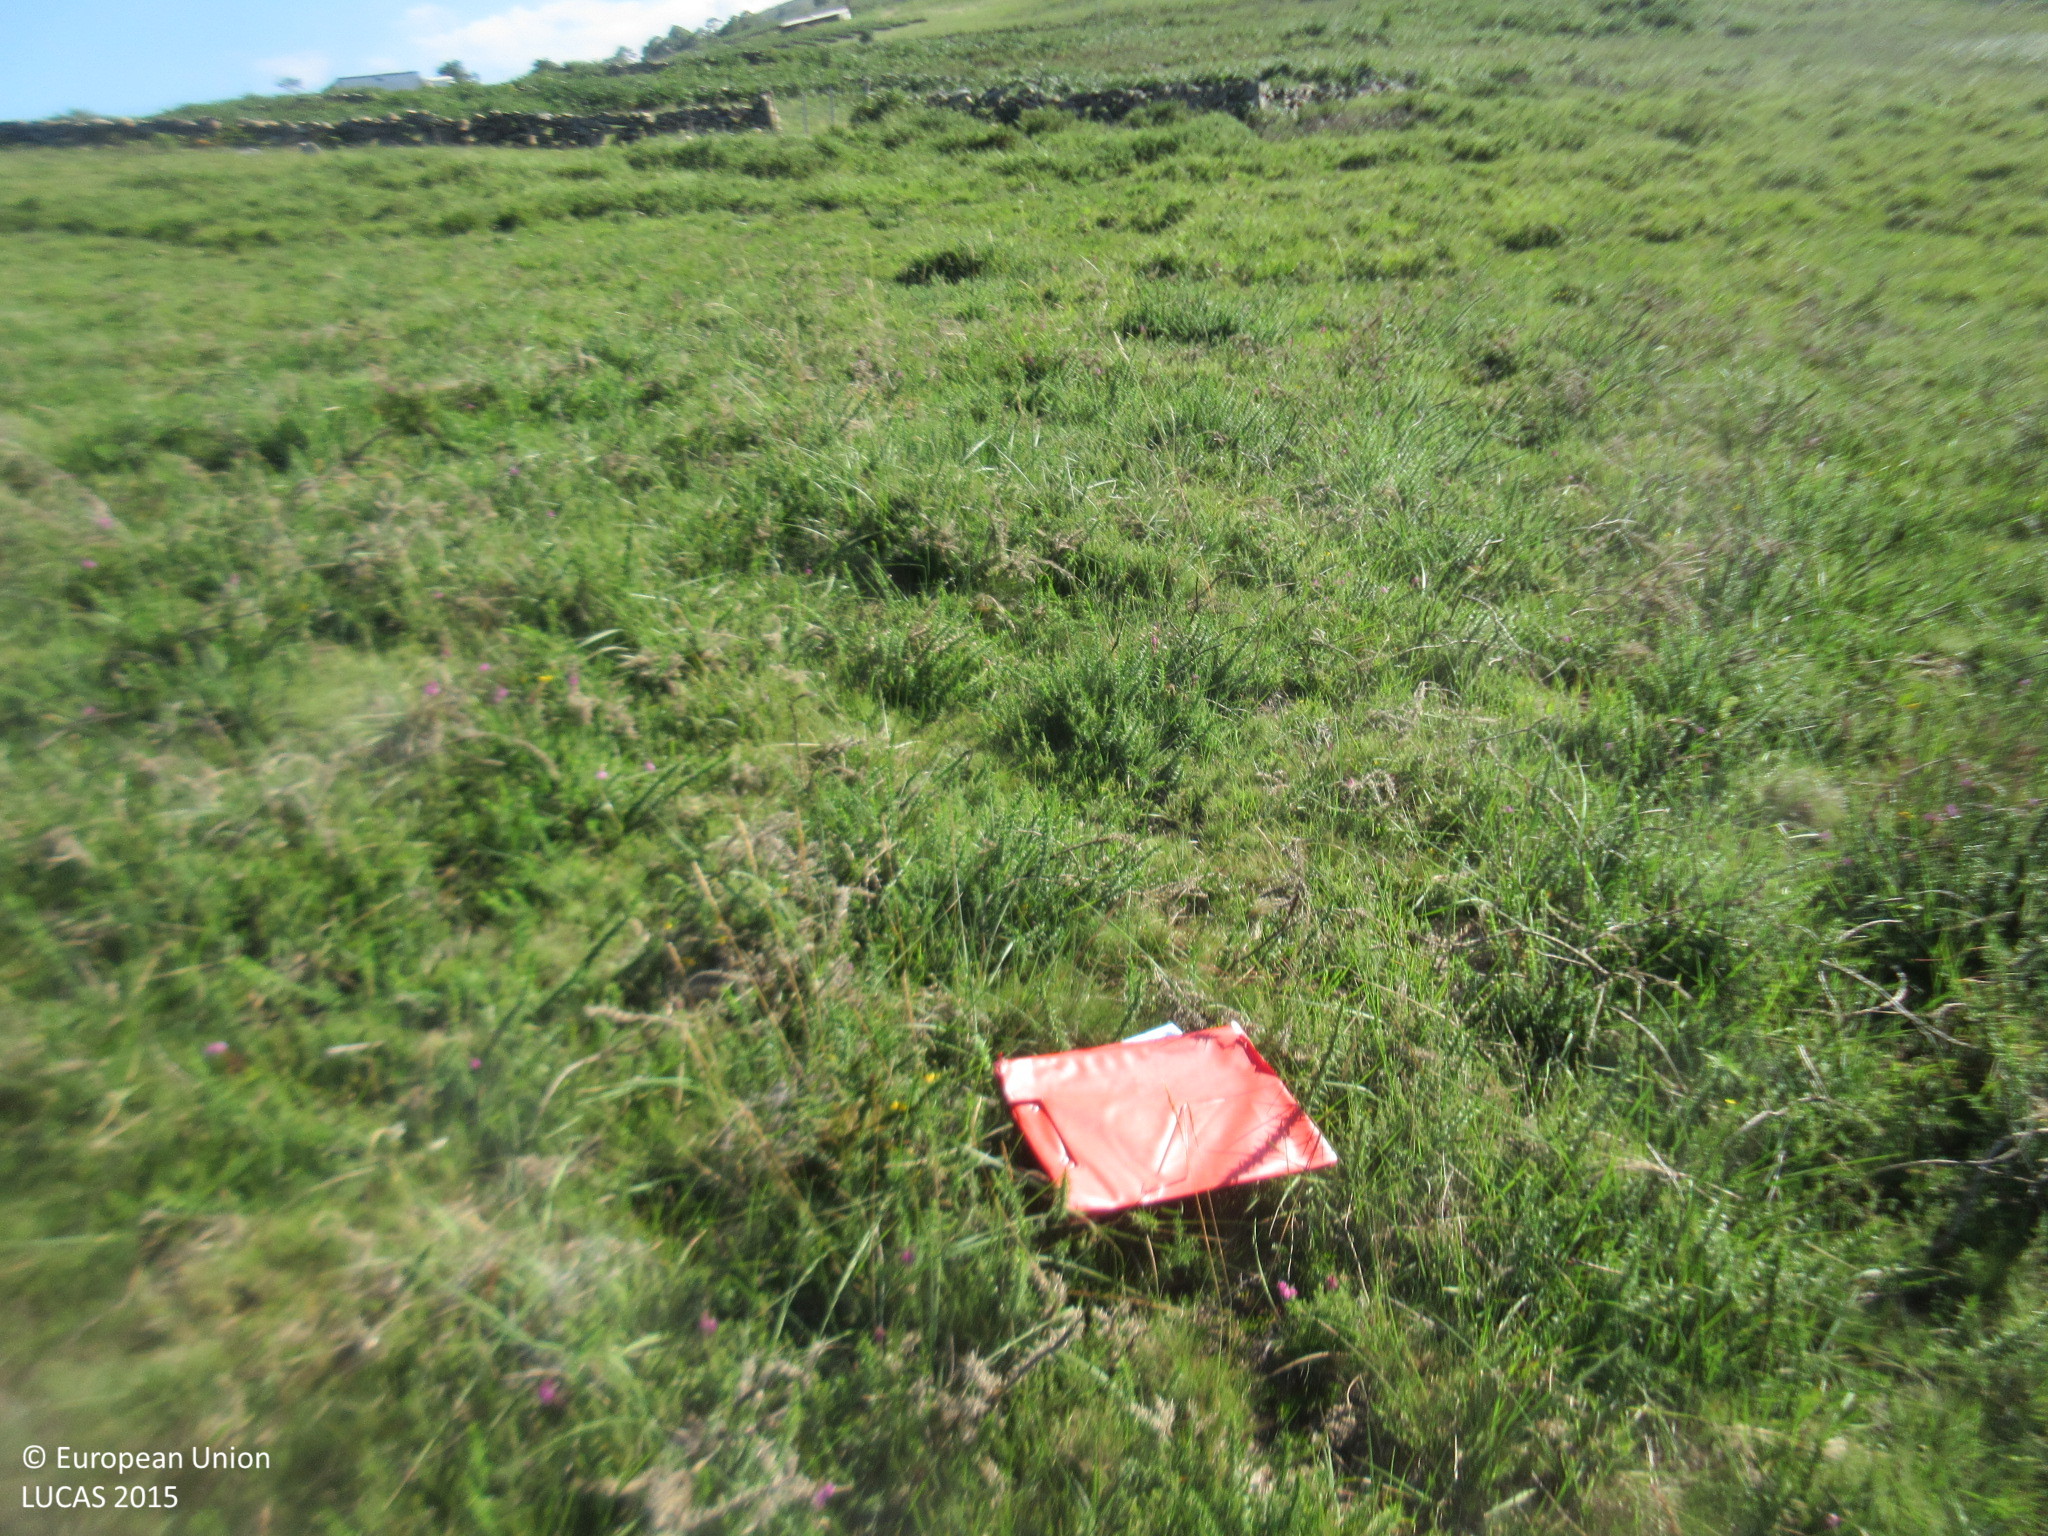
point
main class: Shrubland
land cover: Shrubland without tree cover
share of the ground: > 75 %
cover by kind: shrubs 100 %
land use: Agriculture (excluding fallow land and kitchen gardens)
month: July
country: ES
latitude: 43.1318
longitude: -3.9268
